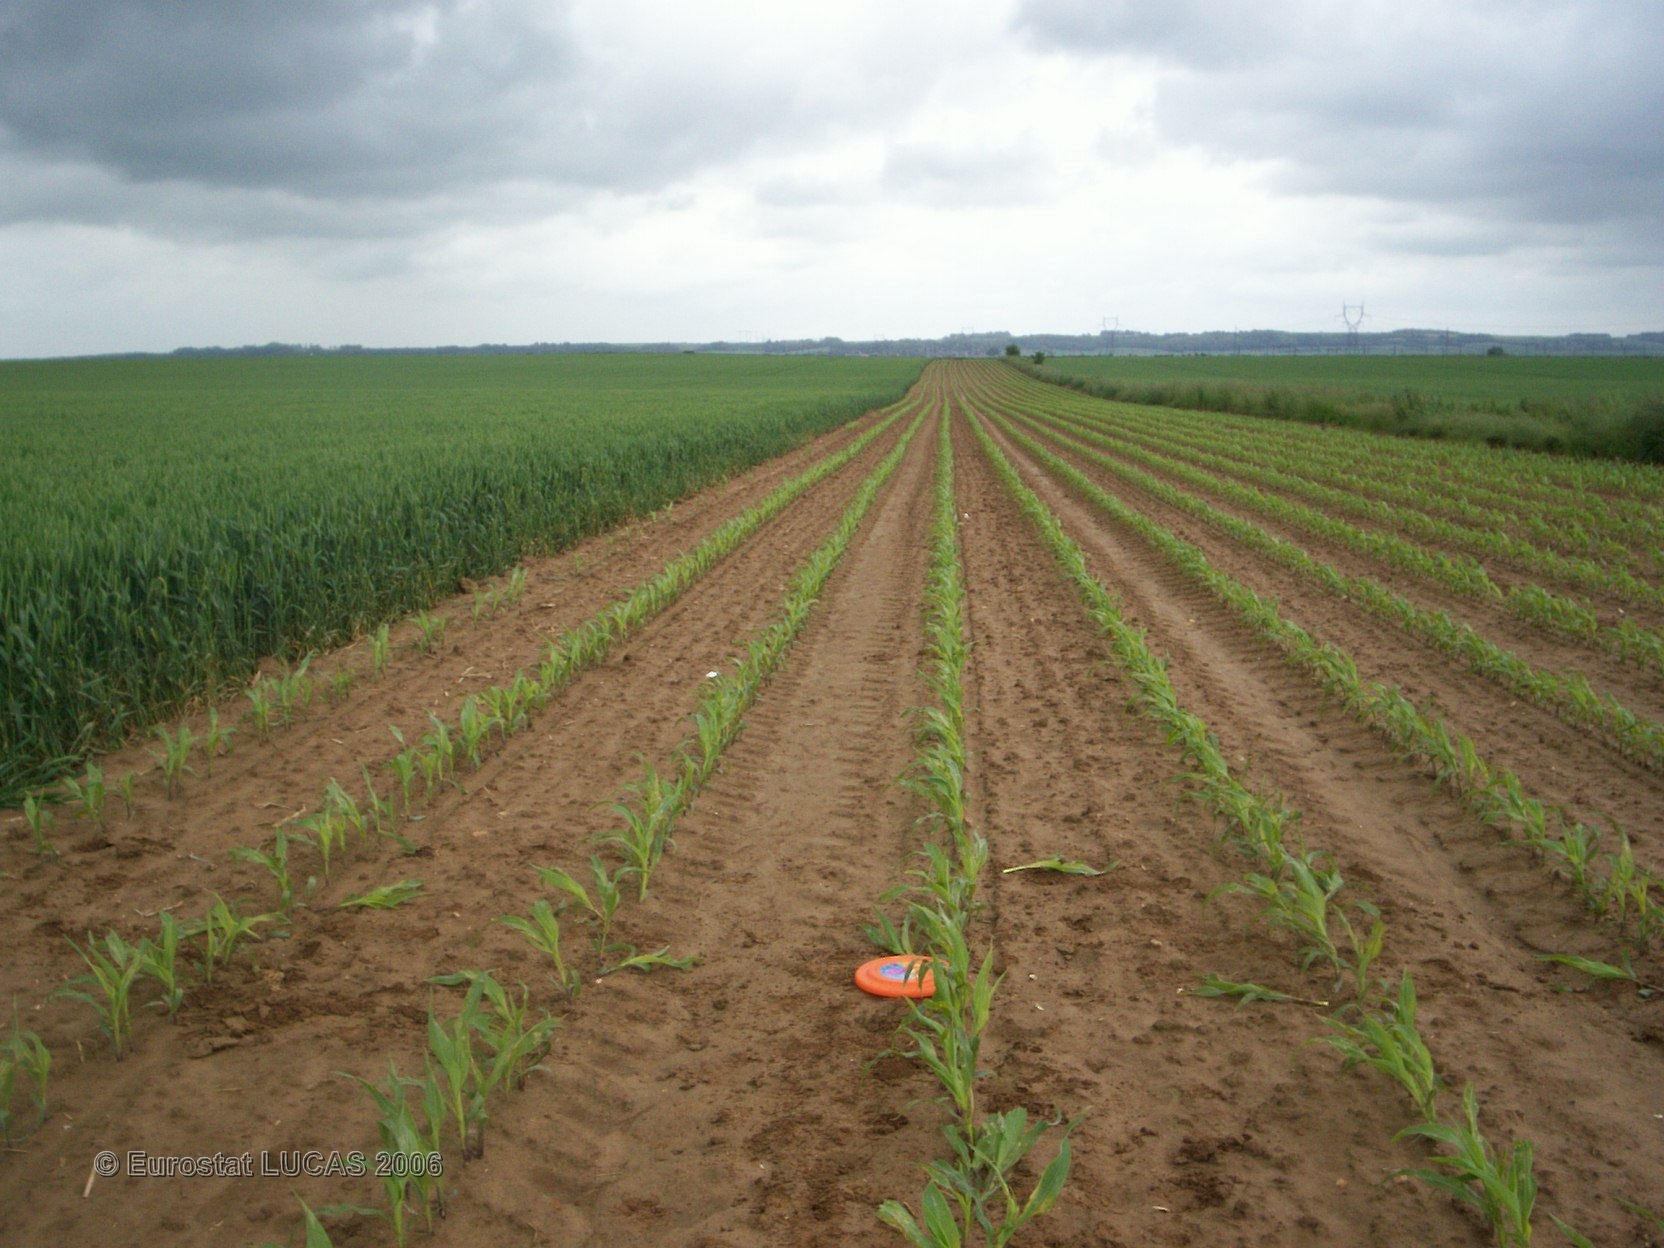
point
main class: Cropland
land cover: Maize
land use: Agriculture (excluding fallow land and kitchen gardens)
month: May
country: FR
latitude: 49.2491
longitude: 2.7498
